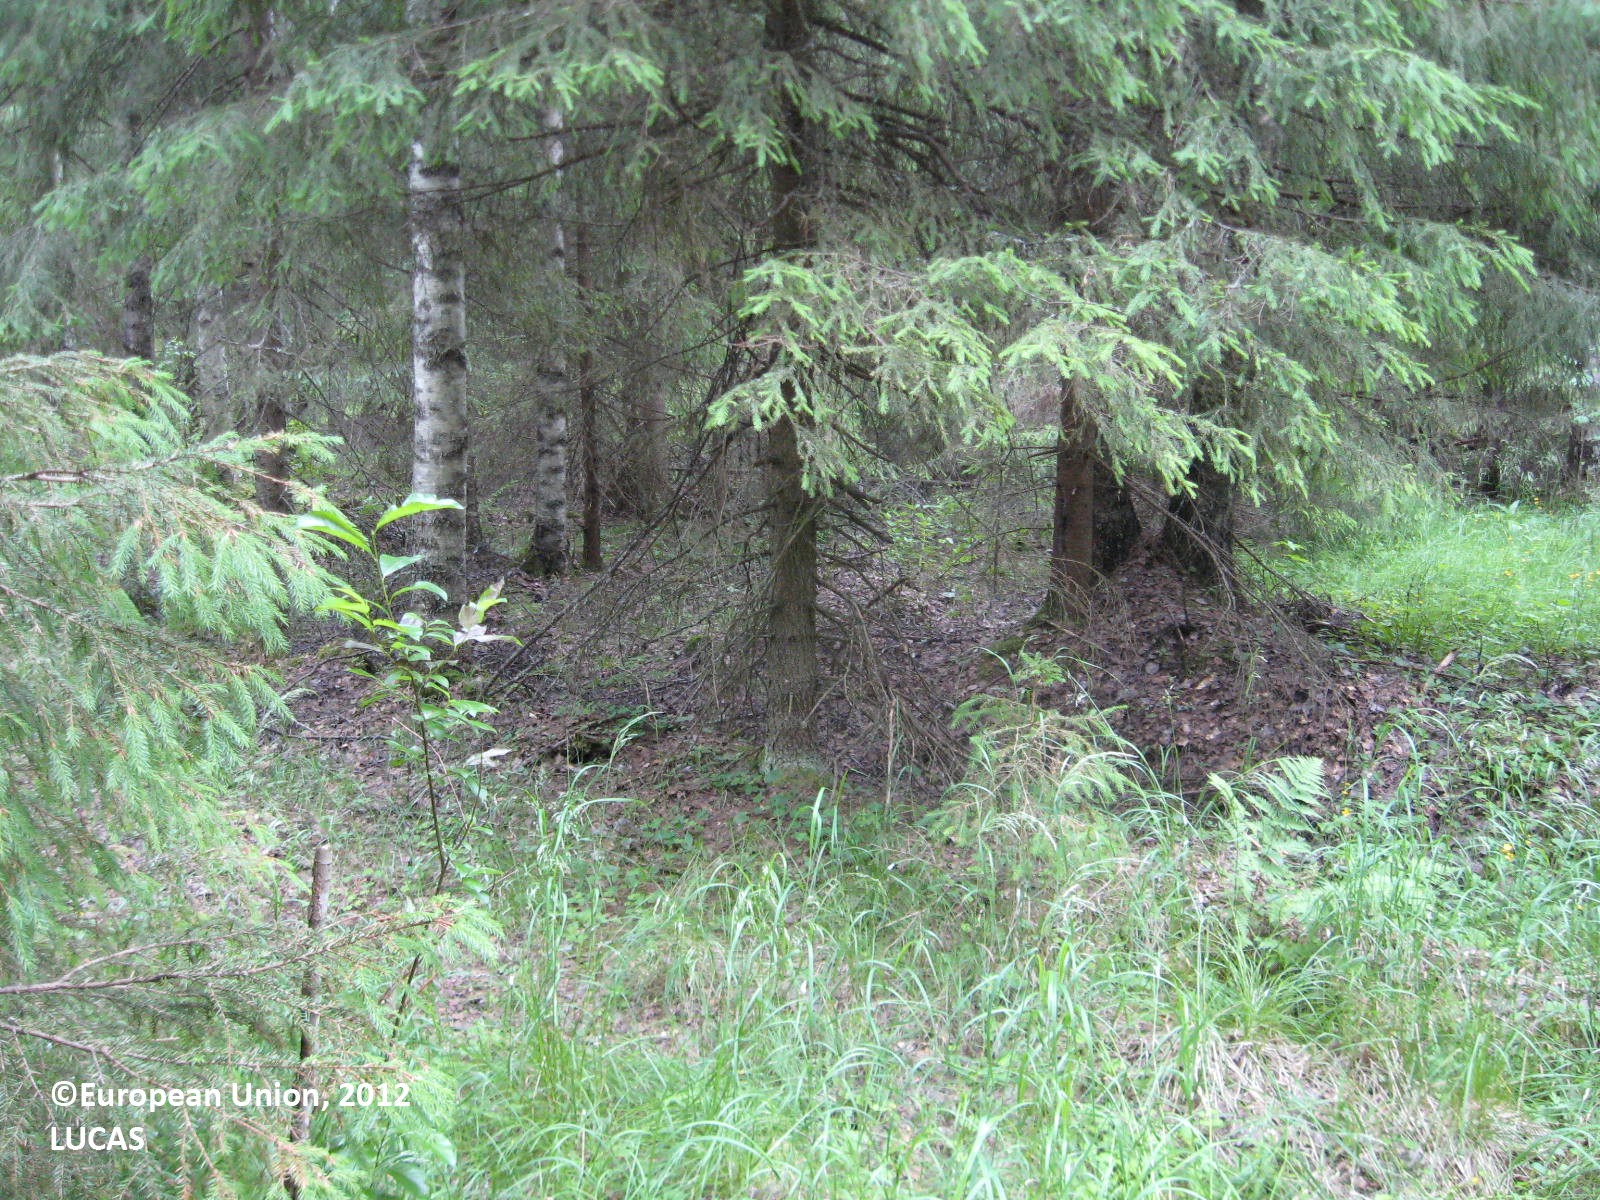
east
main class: Woodland
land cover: Spruce dominated mixed woodland
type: boreal forest
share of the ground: > 75 %
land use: Forestry
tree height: > 5 m
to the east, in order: Spruce dominated mixed woodland; Spruce dominated coniferous woodland; Tracks; Other coniferous woodland; Spruce dominated mixed woodland
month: July
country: FI
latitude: 62.5015
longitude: 22.8149
